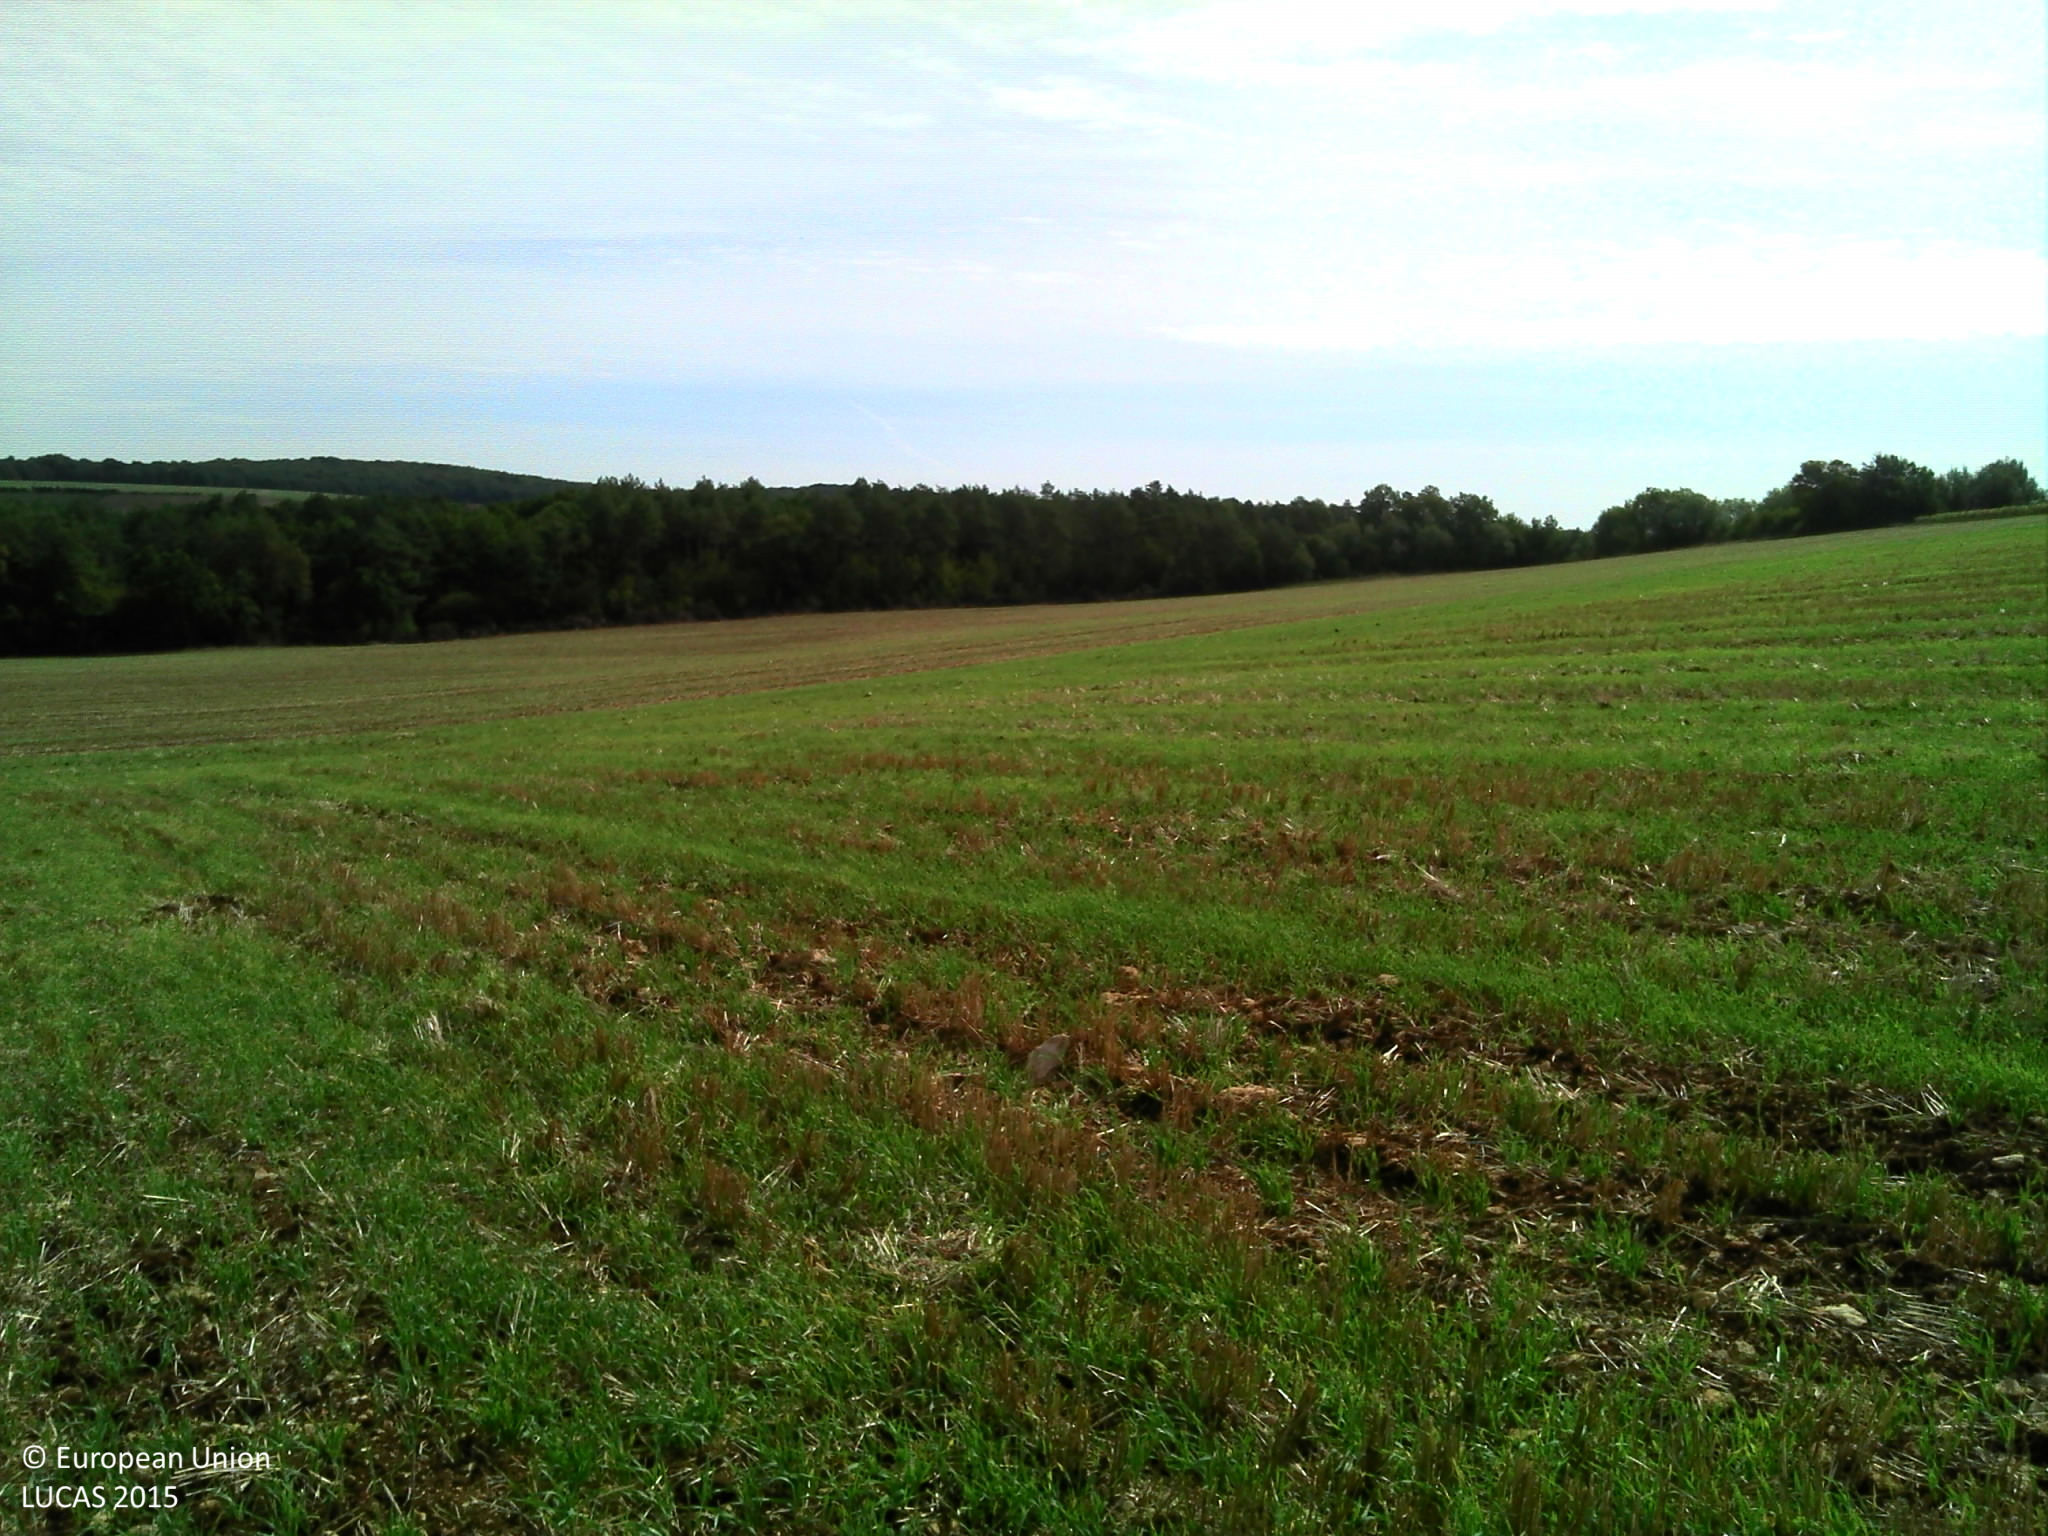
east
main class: Cropland
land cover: Barley
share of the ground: > 75 %
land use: Agriculture (excluding fallow land and kitchen gardens)
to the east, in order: Barley; Common wheat
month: August
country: FR
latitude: 47.6727
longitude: 4.8985
